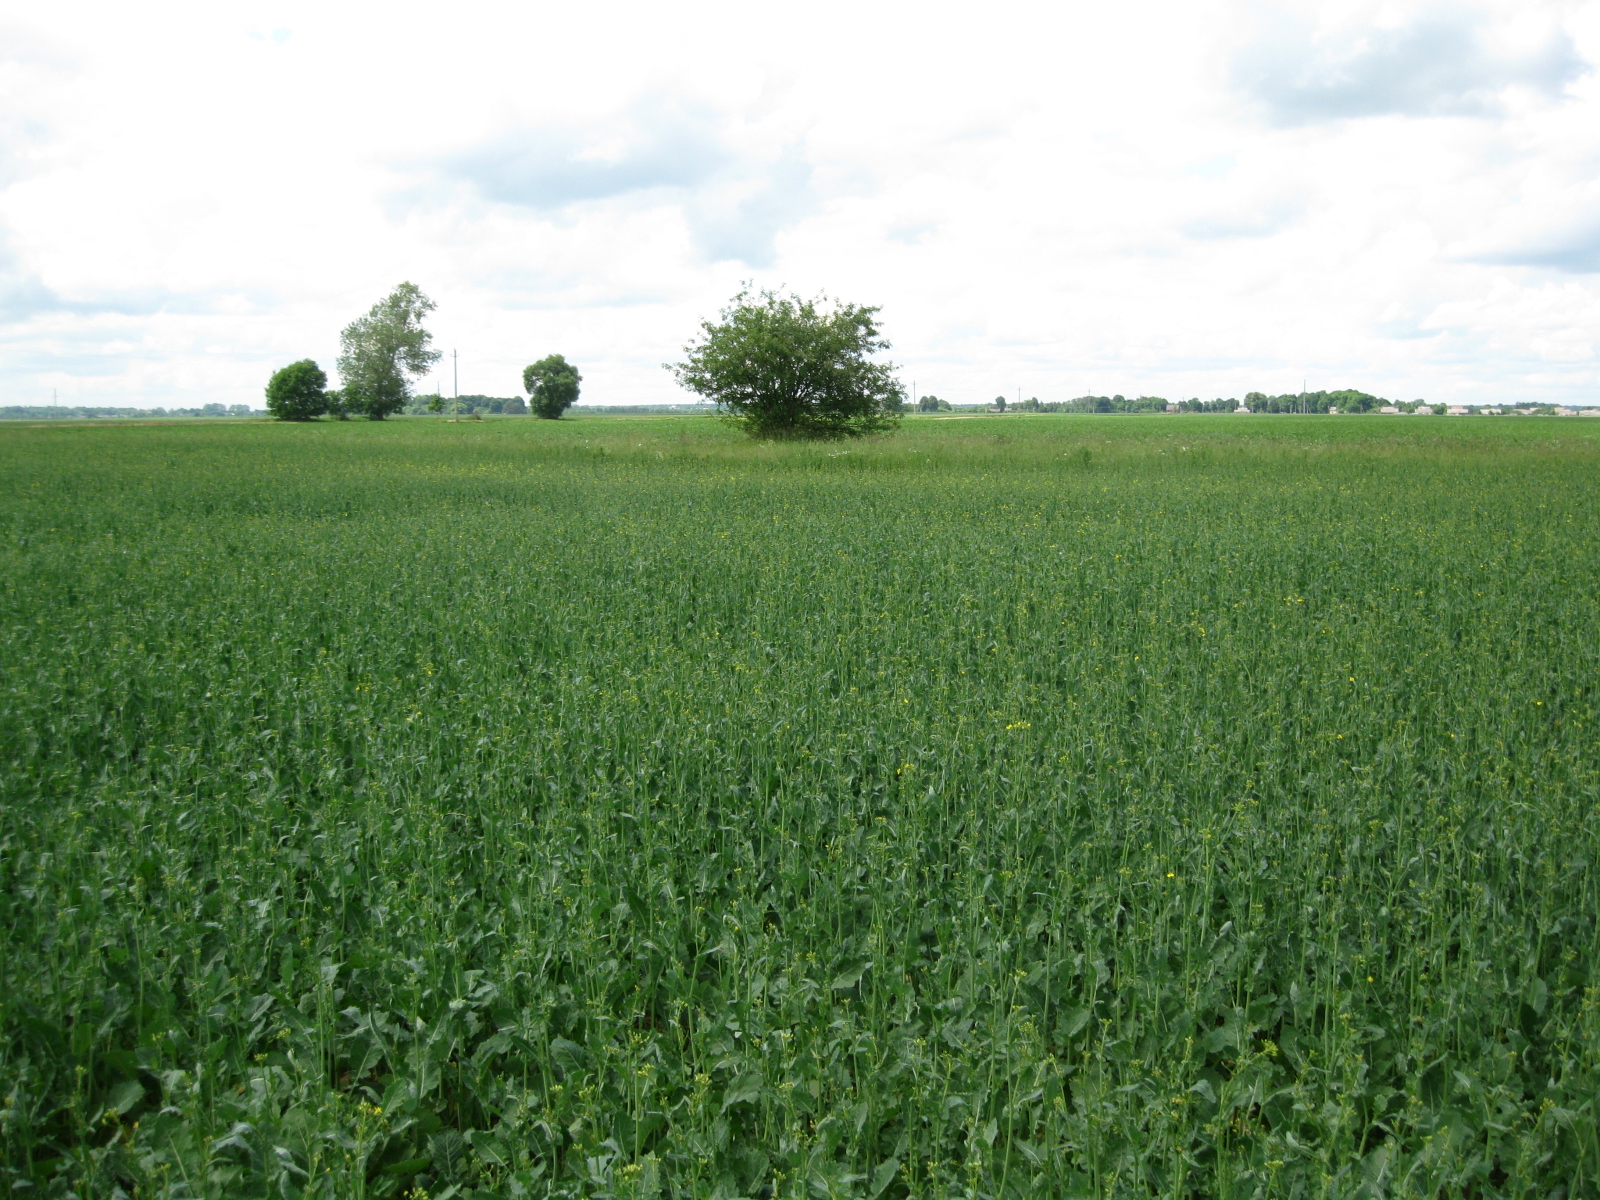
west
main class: Cropland
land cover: Rape and turnip rape
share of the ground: > 75 %
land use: Agriculture (excluding fallow land and kitchen gardens)
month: June
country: LT
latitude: 55.4073
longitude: 24.0682
